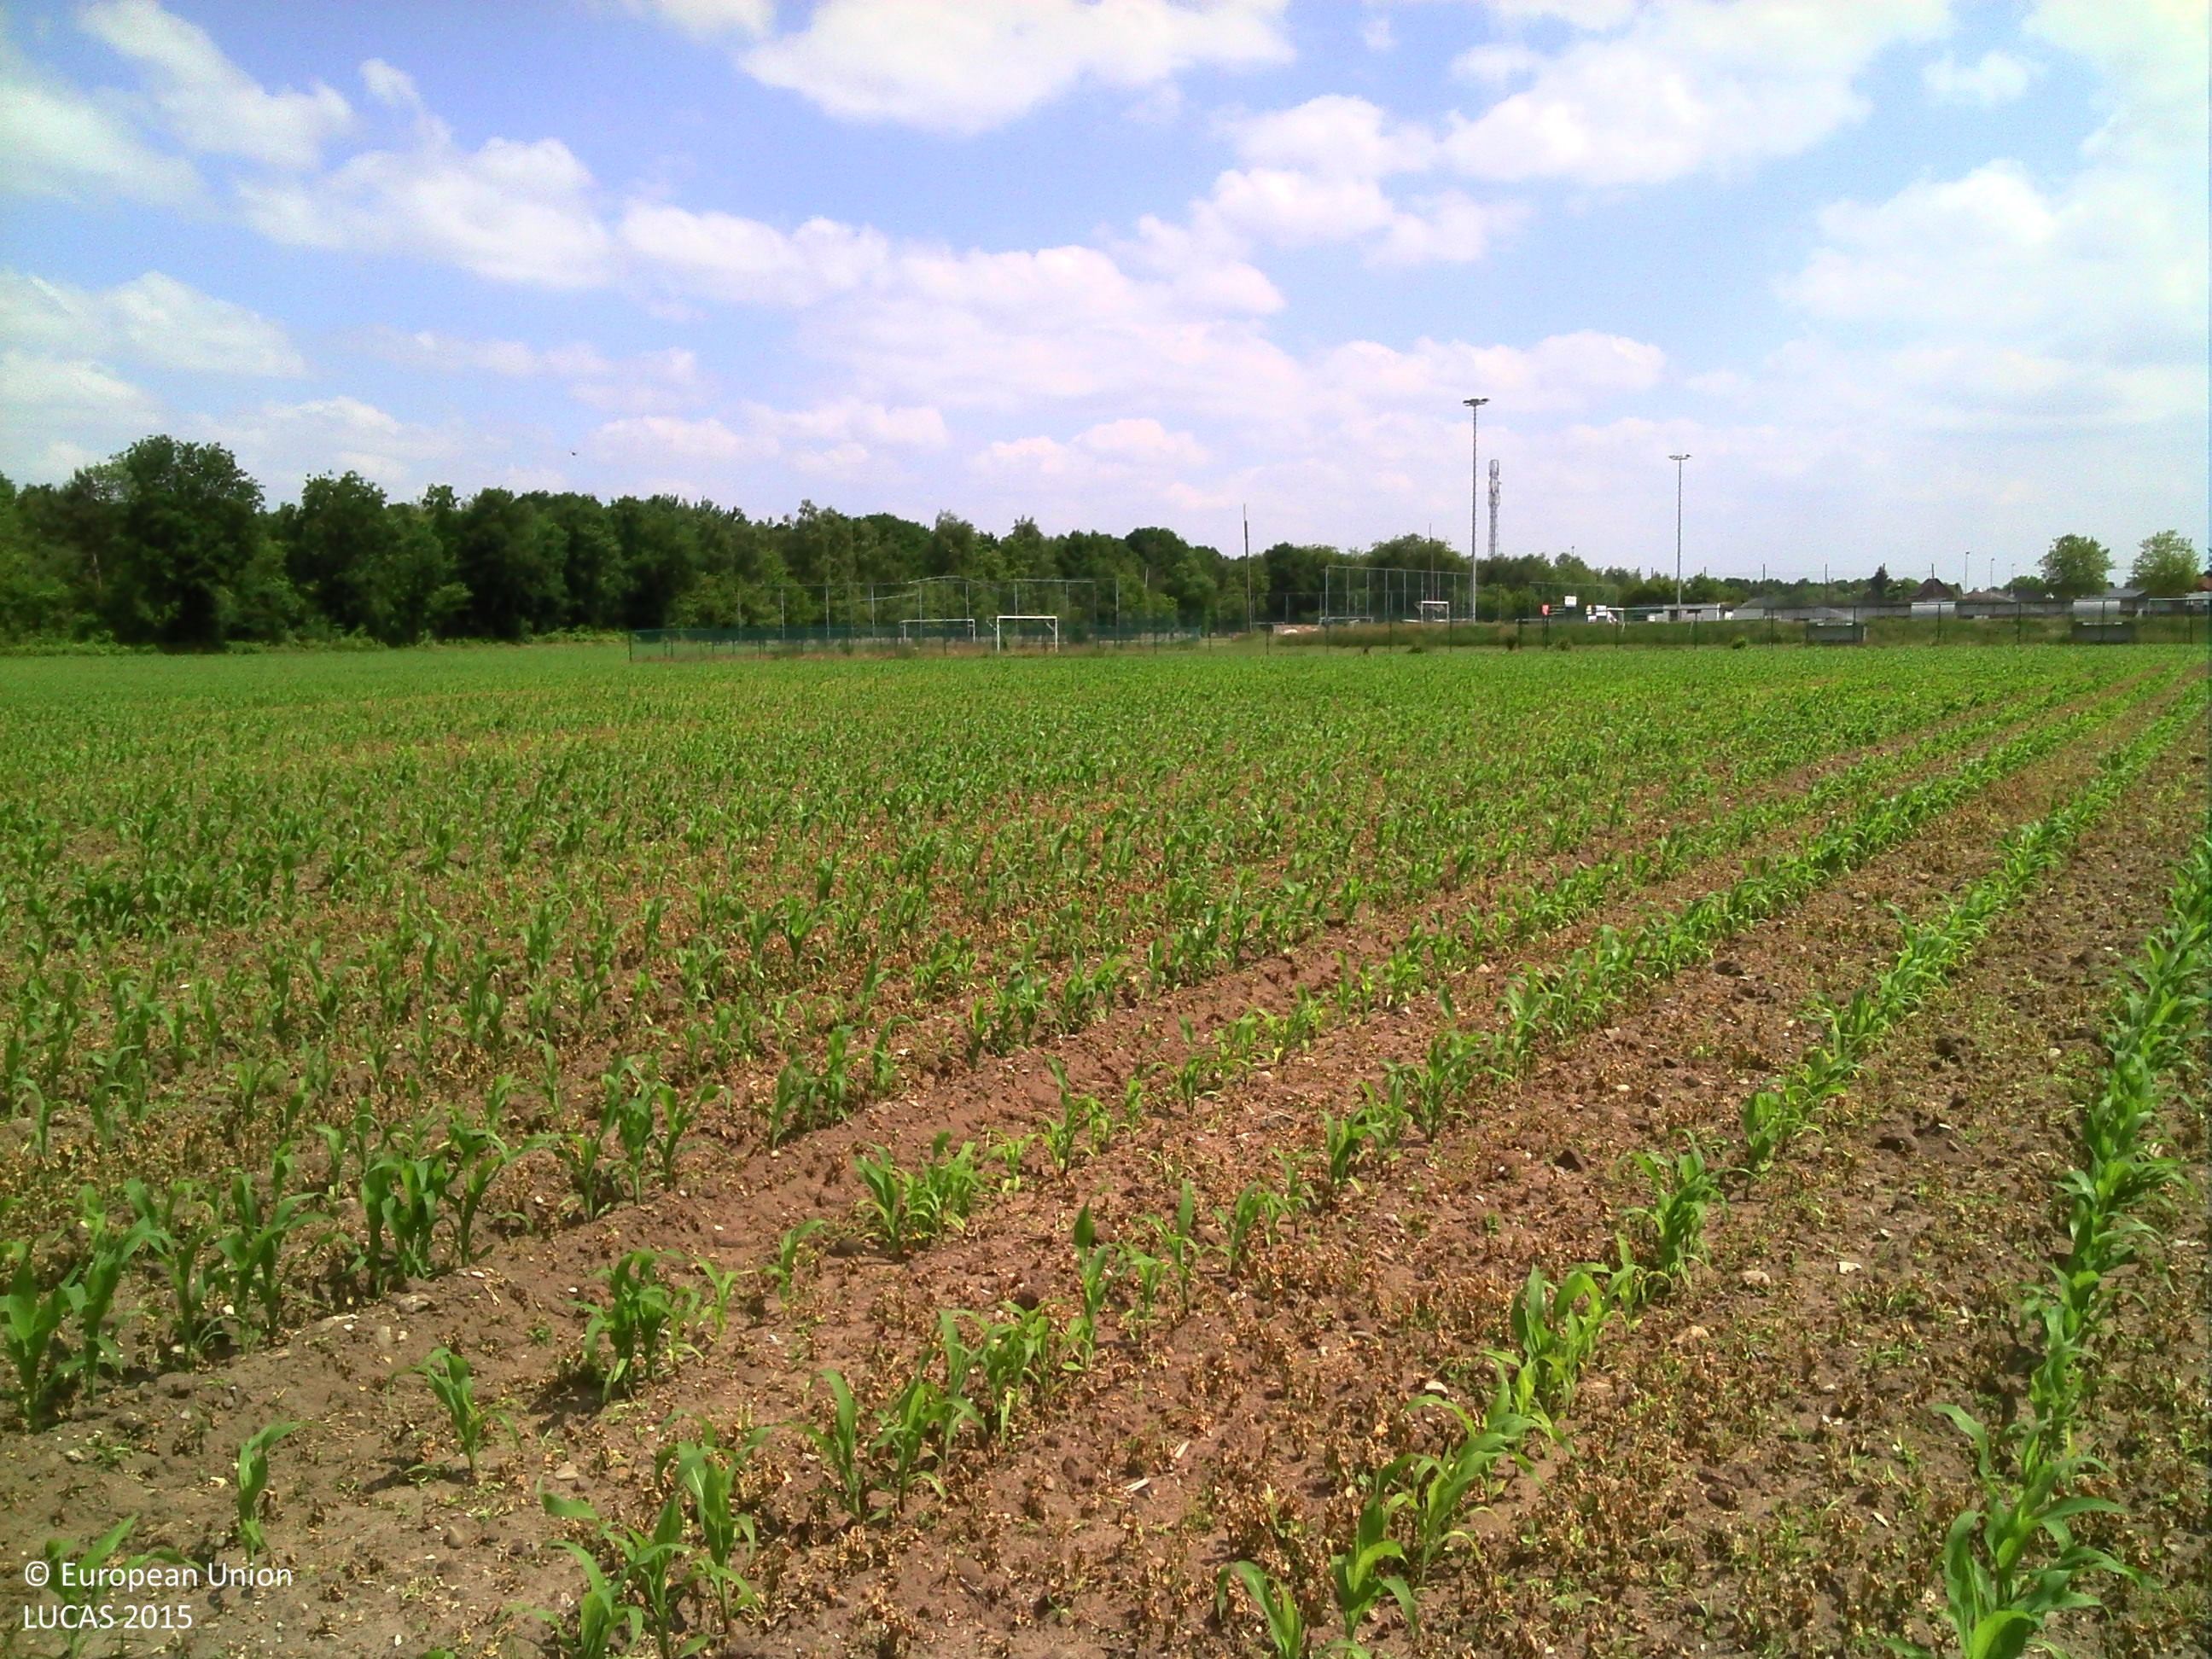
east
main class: Cropland
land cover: Maize
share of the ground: 10 - 25 %
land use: Agriculture (excluding fallow land and kitchen gardens)
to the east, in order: Maize; Grass margins; Fences; Grassland without tree/shrub cover; Fences; Grass margins; Maize; Grass margins; Fences; Grassland without tree/shrub cover
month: June
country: BE
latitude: 50.9848
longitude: 5.6822
